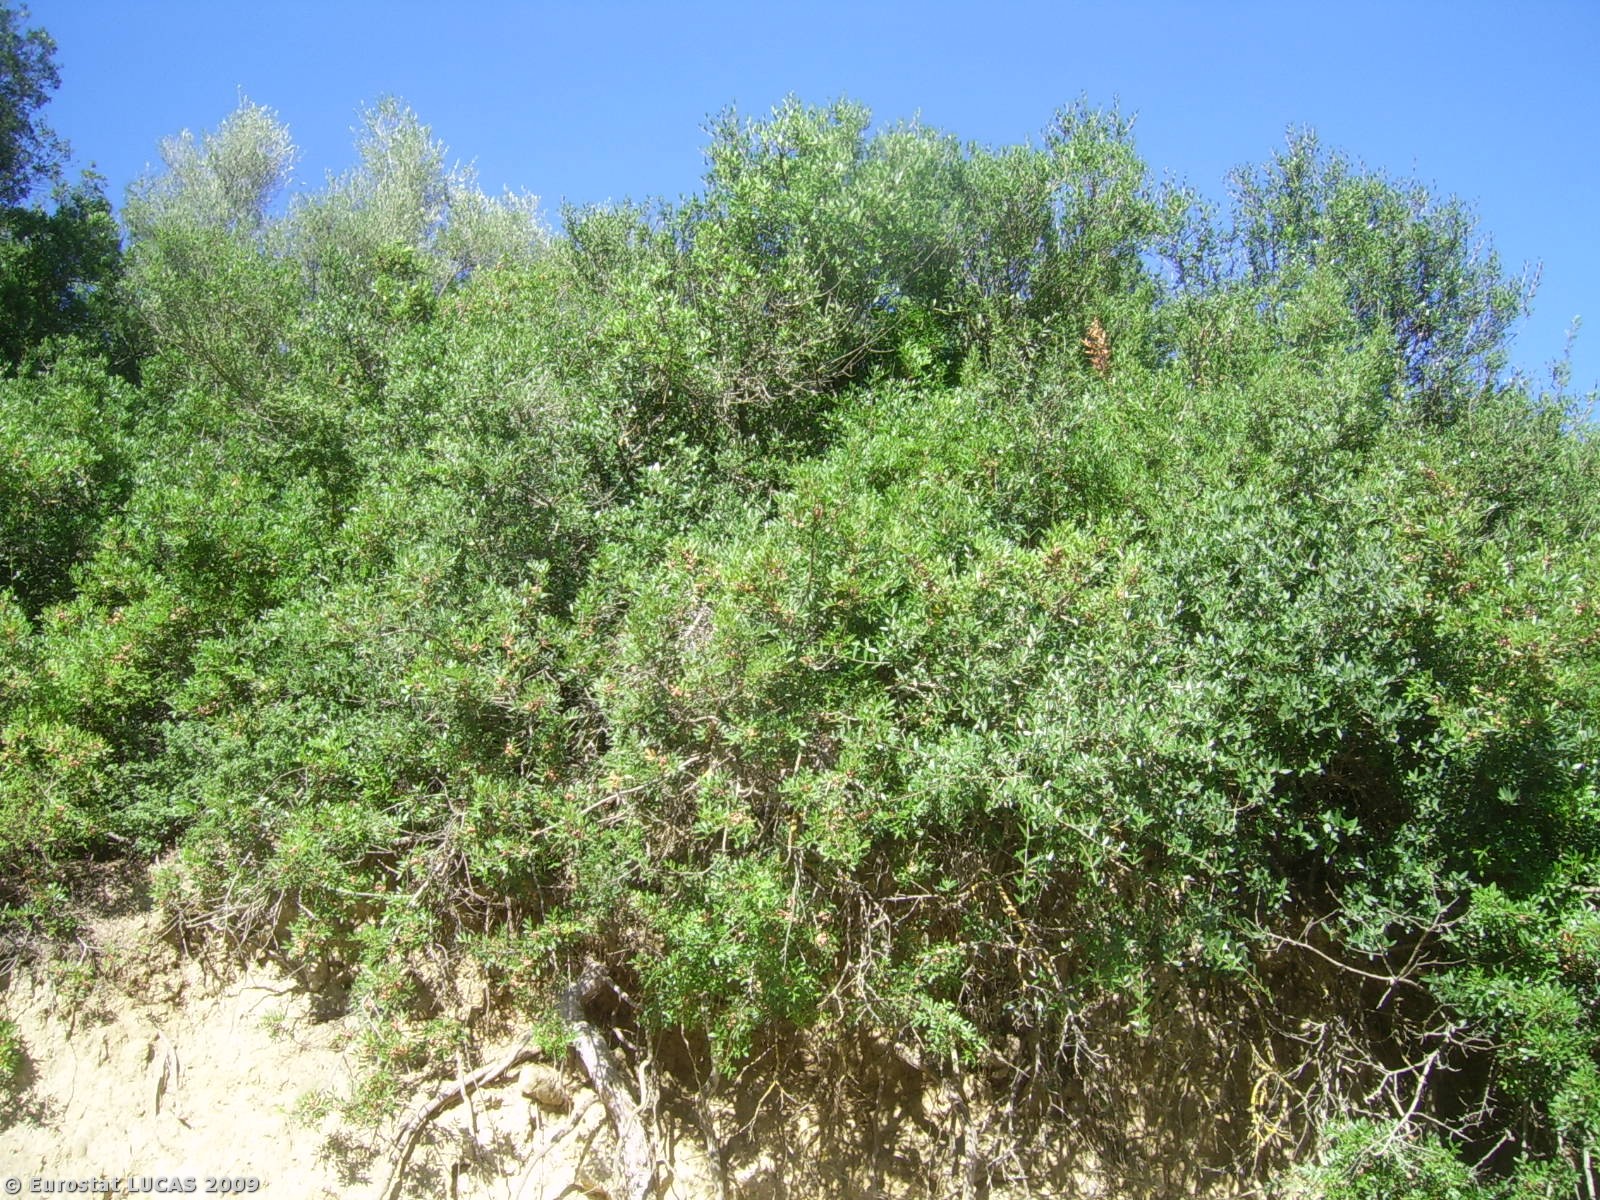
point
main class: Shrubland
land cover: Shrubland with sparse tree cover
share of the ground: > 75 %
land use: Unused
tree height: > 5 m
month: October
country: GR
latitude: 37.8817
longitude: 21.4104
